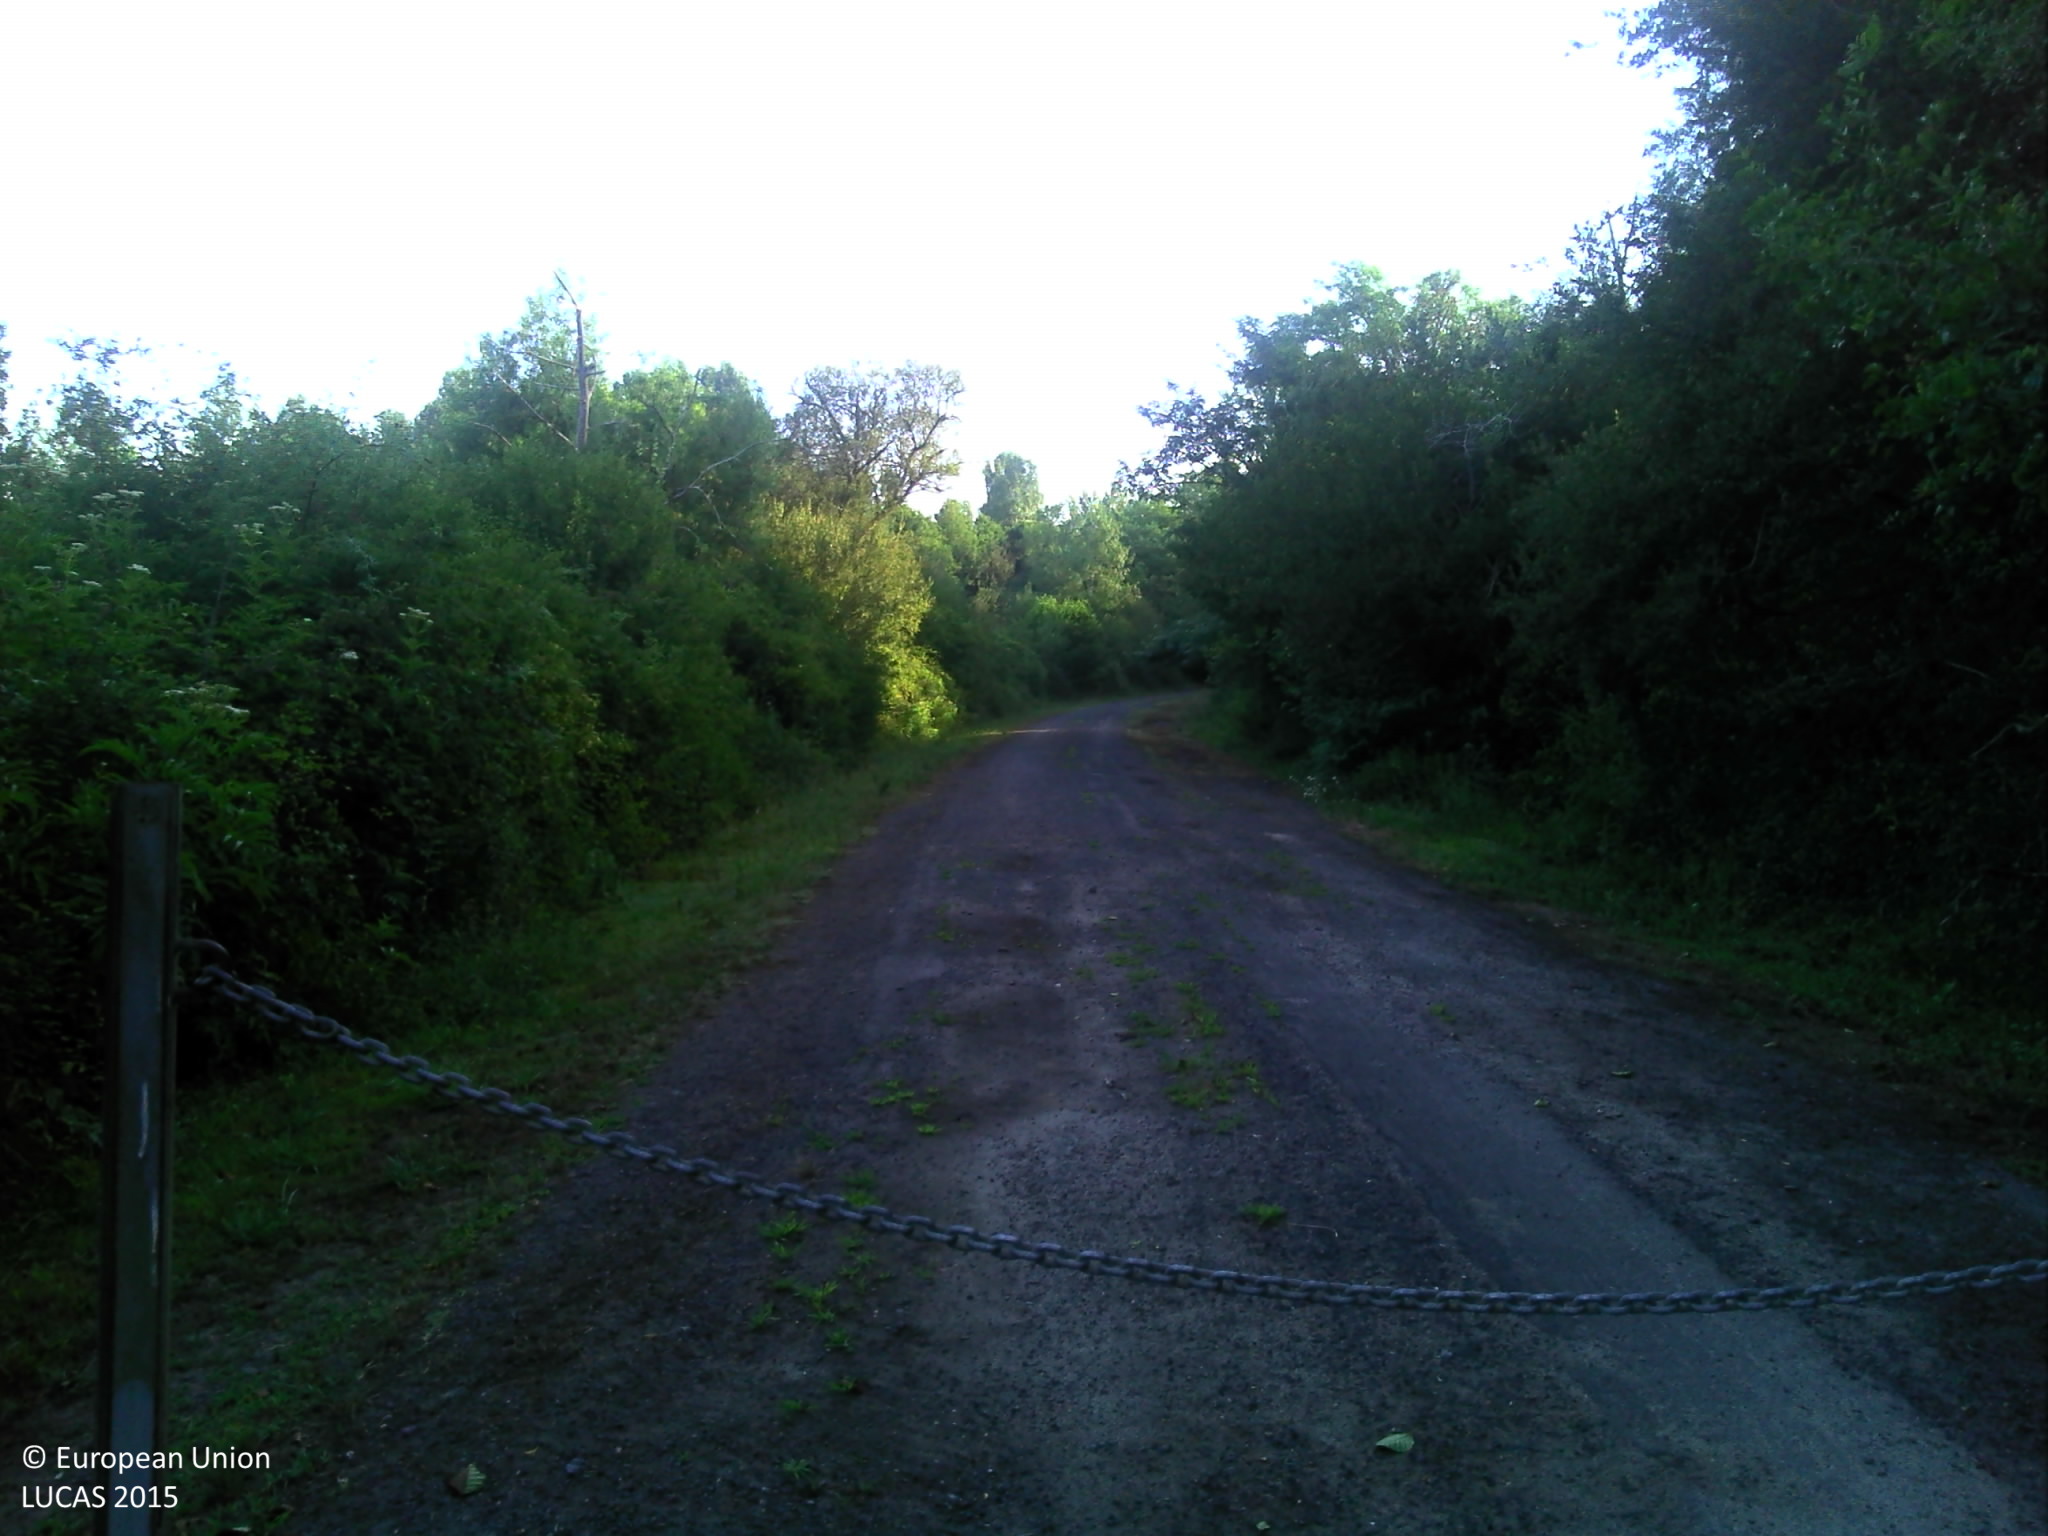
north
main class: Woodland
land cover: Broadleaved woodland
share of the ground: > 75 %
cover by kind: broadleaved forest trees 85 %, herbaceous plants 10 %, lichens and mosses 5 %
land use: Semi-natural and natural areas not in use
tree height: > 5 m
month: July
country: FR
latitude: 43.6784
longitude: -1.1177
